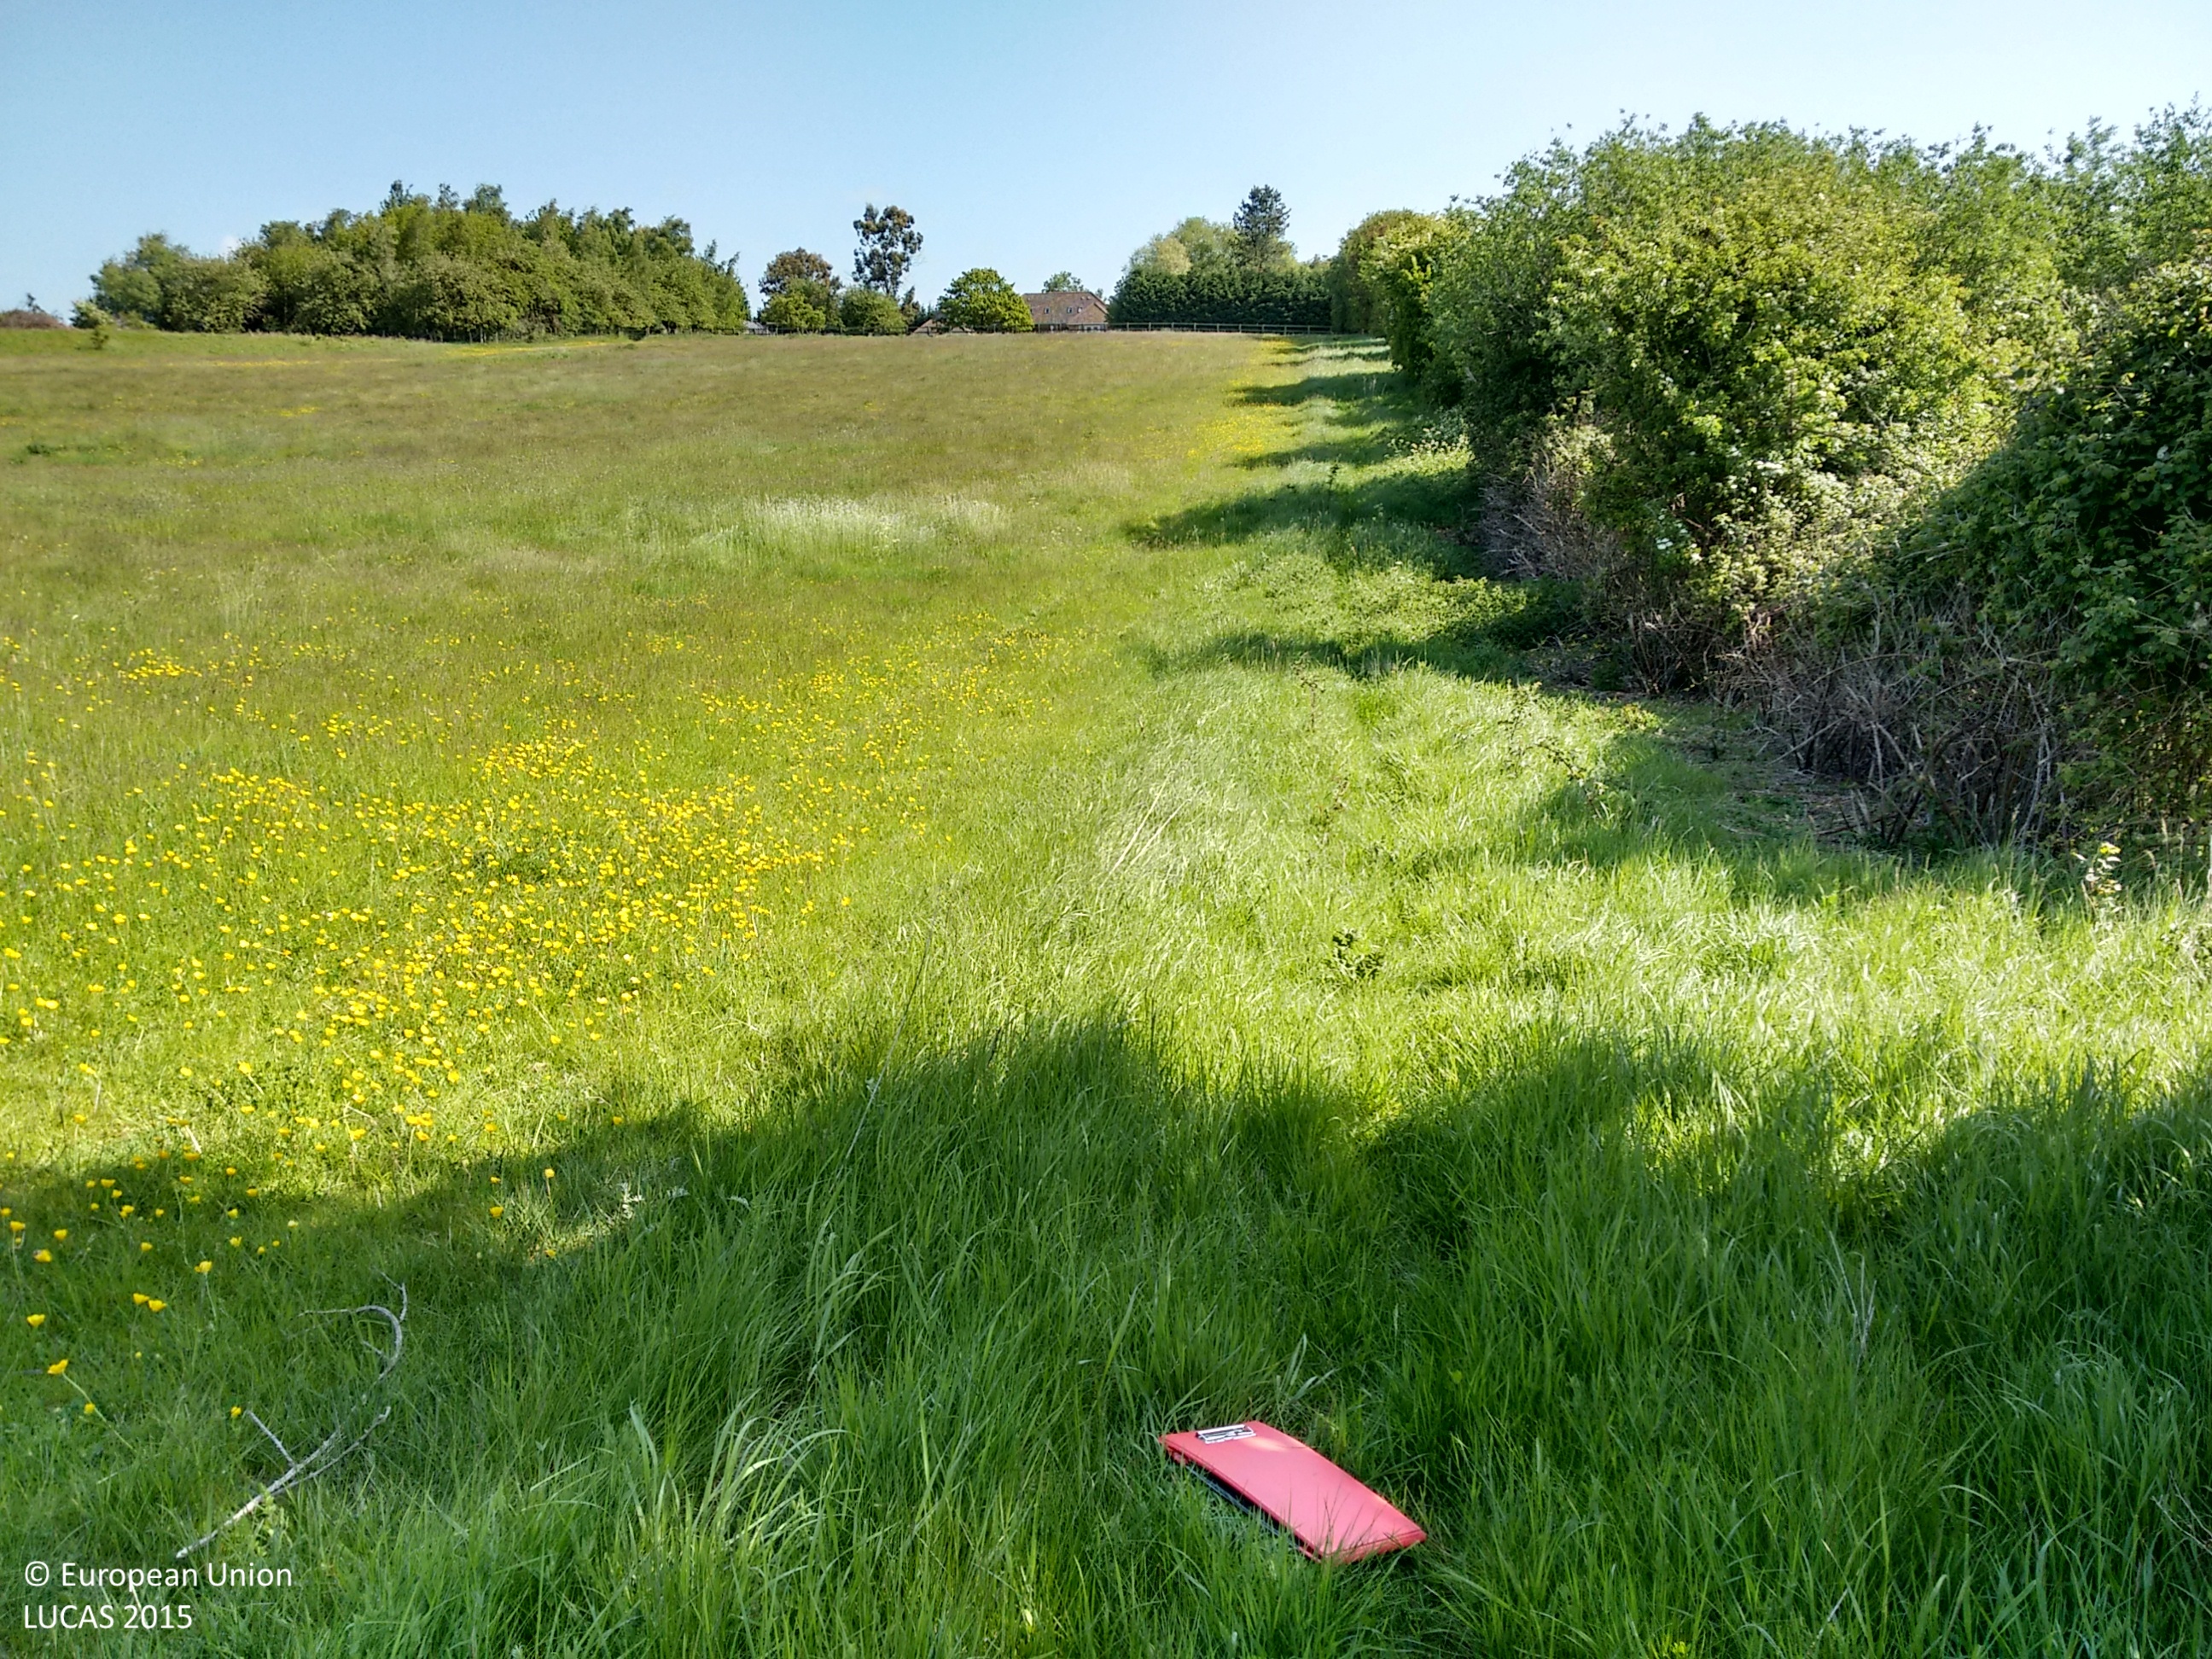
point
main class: Grassland
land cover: Grassland without tree/shrub cover
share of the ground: > 75 %
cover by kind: herbaceous plants 100 %
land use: Agriculture (excluding fallow land and kitchen gardens)
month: May
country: GB
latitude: 52.0408
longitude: -0.4619
